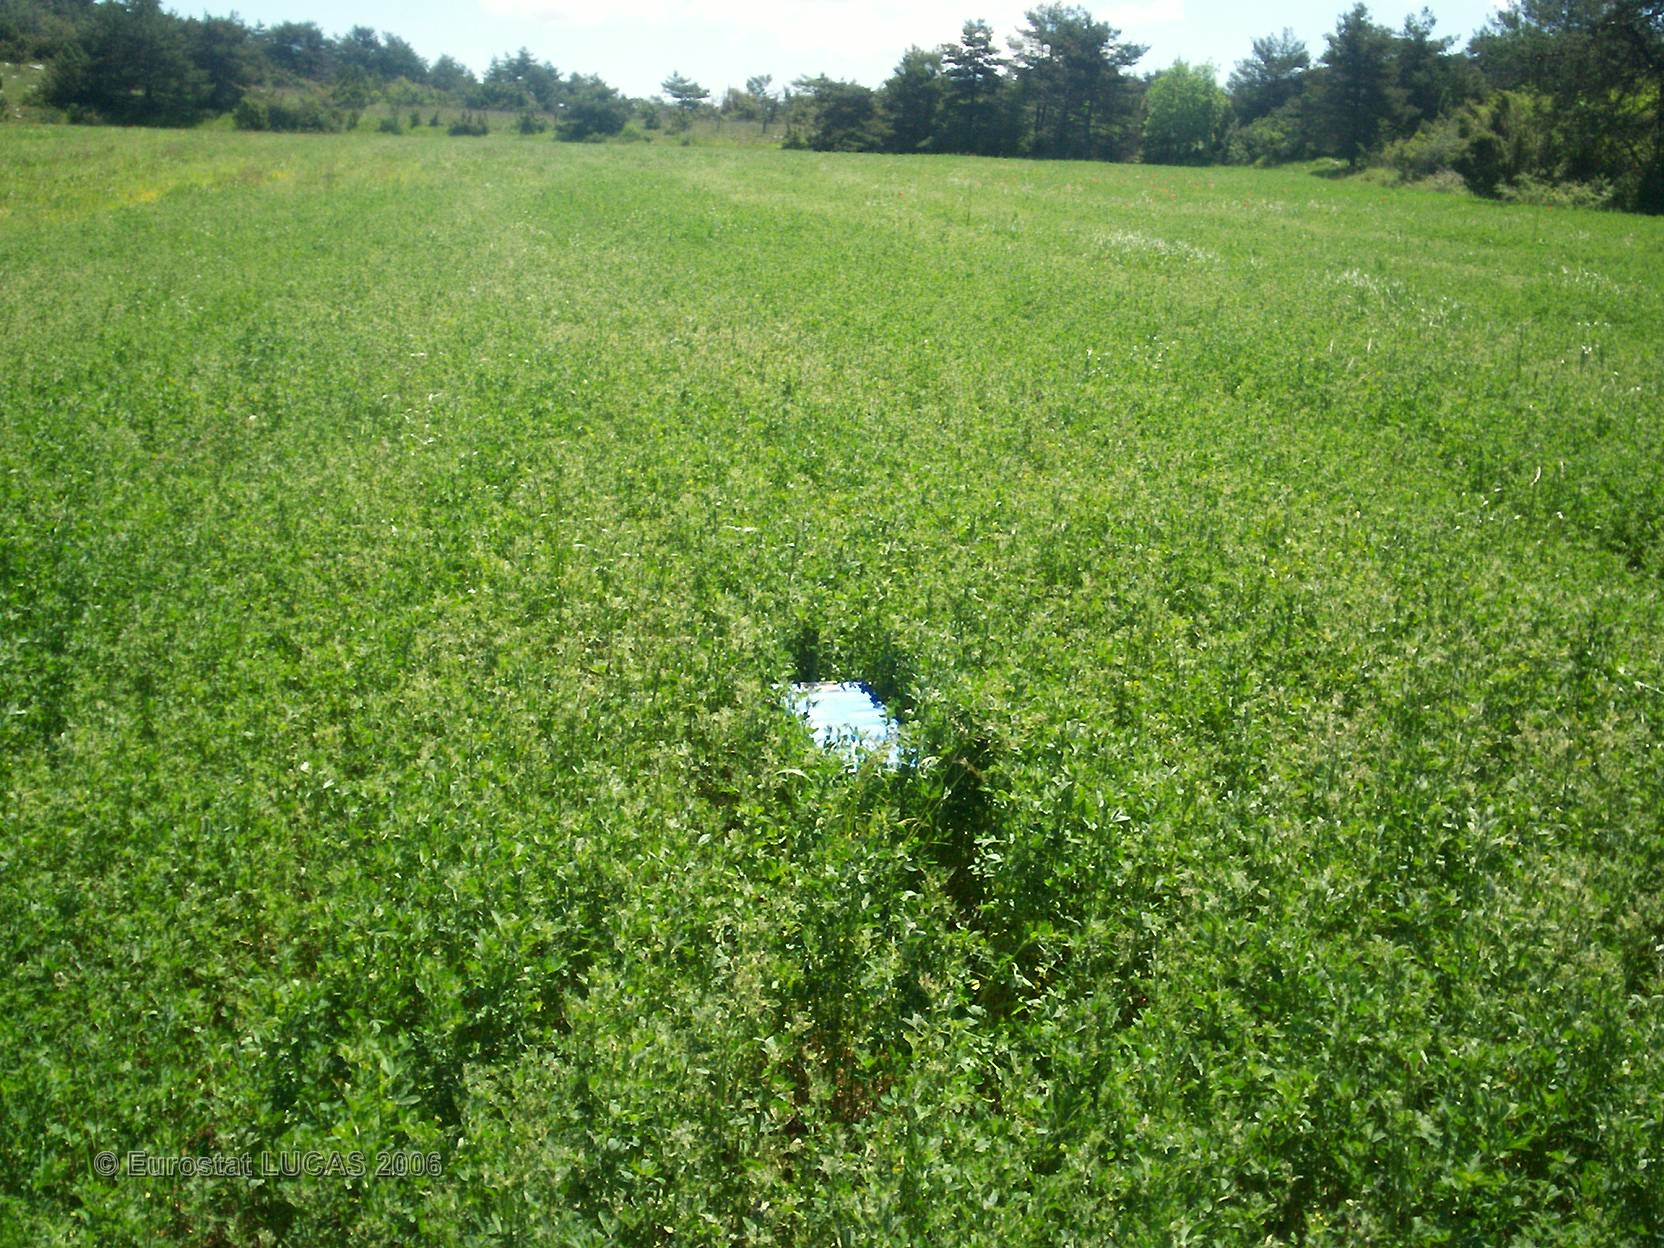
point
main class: Cropland
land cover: Other leguminous and mixtures for fodder
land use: Agriculture (excluding fallow land and kitchen gardens)
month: June
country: FR
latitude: 44.4077
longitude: 3.3374
